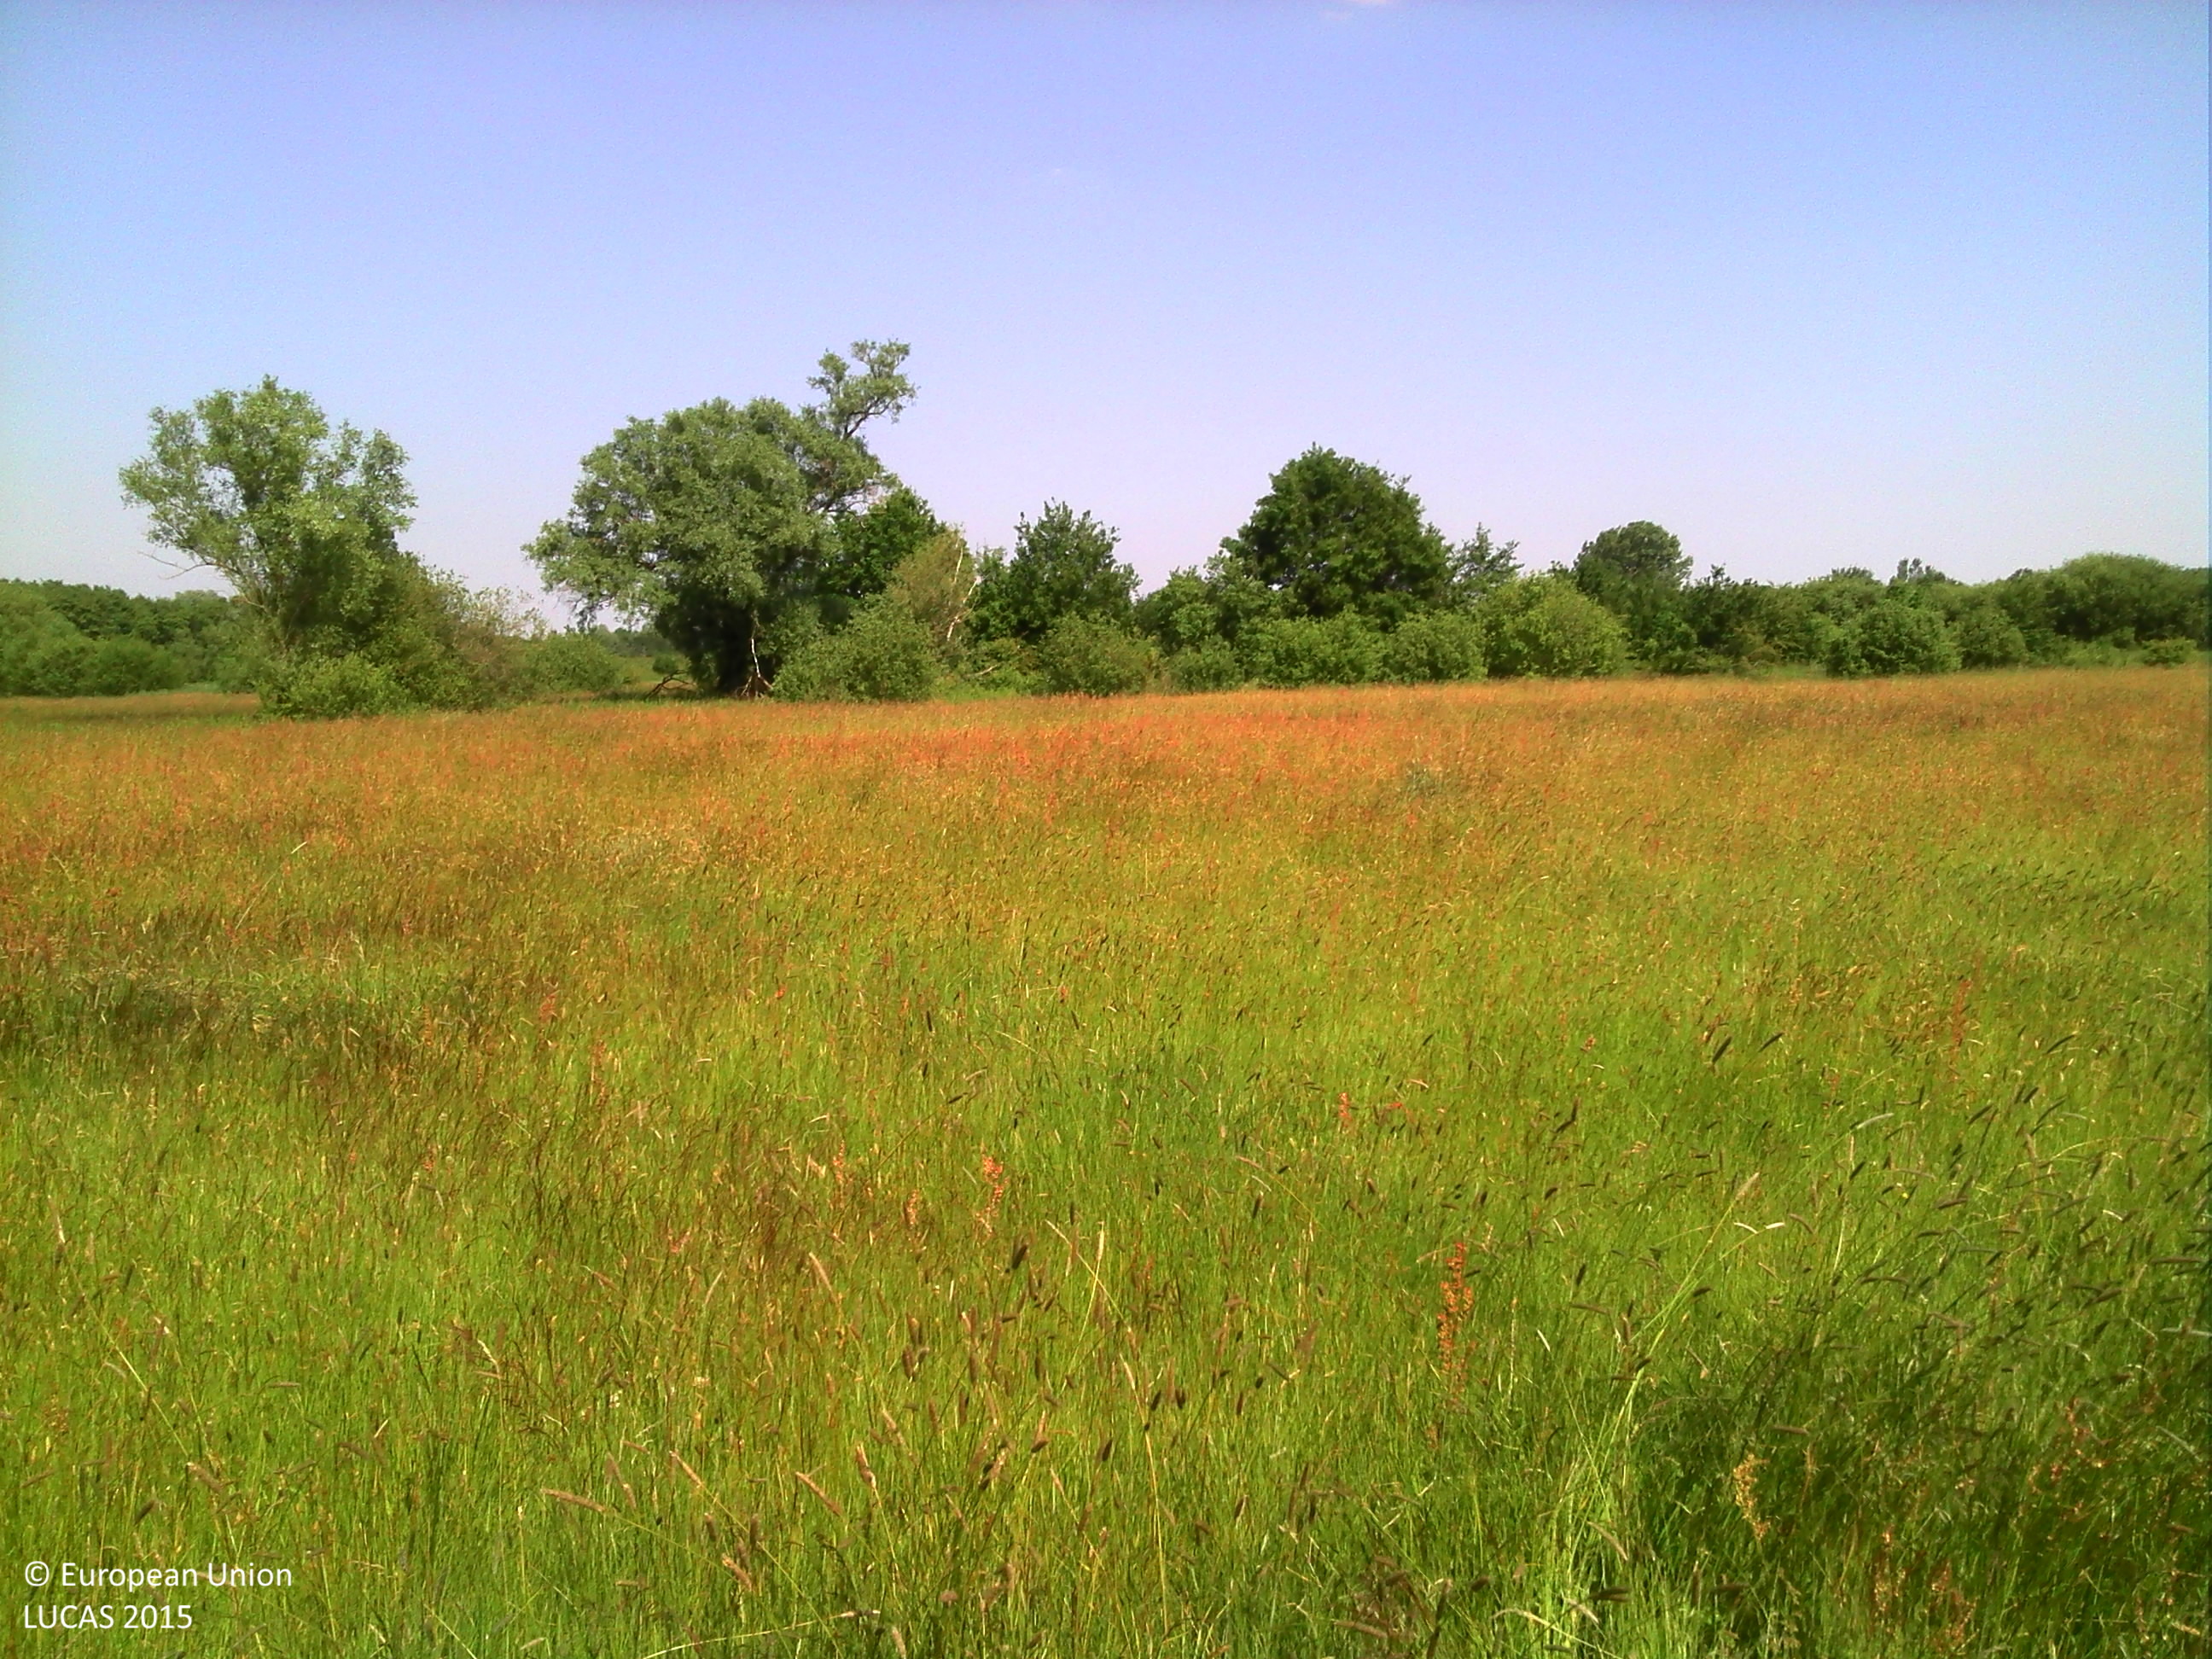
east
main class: Grassland
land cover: Grassland without tree/shrub cover
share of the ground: > 75 %
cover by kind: herbaceous plants 100 %
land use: Agriculture (excluding fallow land and kitchen gardens)
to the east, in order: Grassland without tree/shrub cover; Ditches and canals; Tracks; Ditches and canals; Broadleaved woodland; Grassland without tree/shrub cover; Ditches and canals; Grassland without tree/shrub cover; Ditches and canals; Grassland without tree/shrub cover
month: June
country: BE
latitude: 50.9646
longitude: 5.1705
